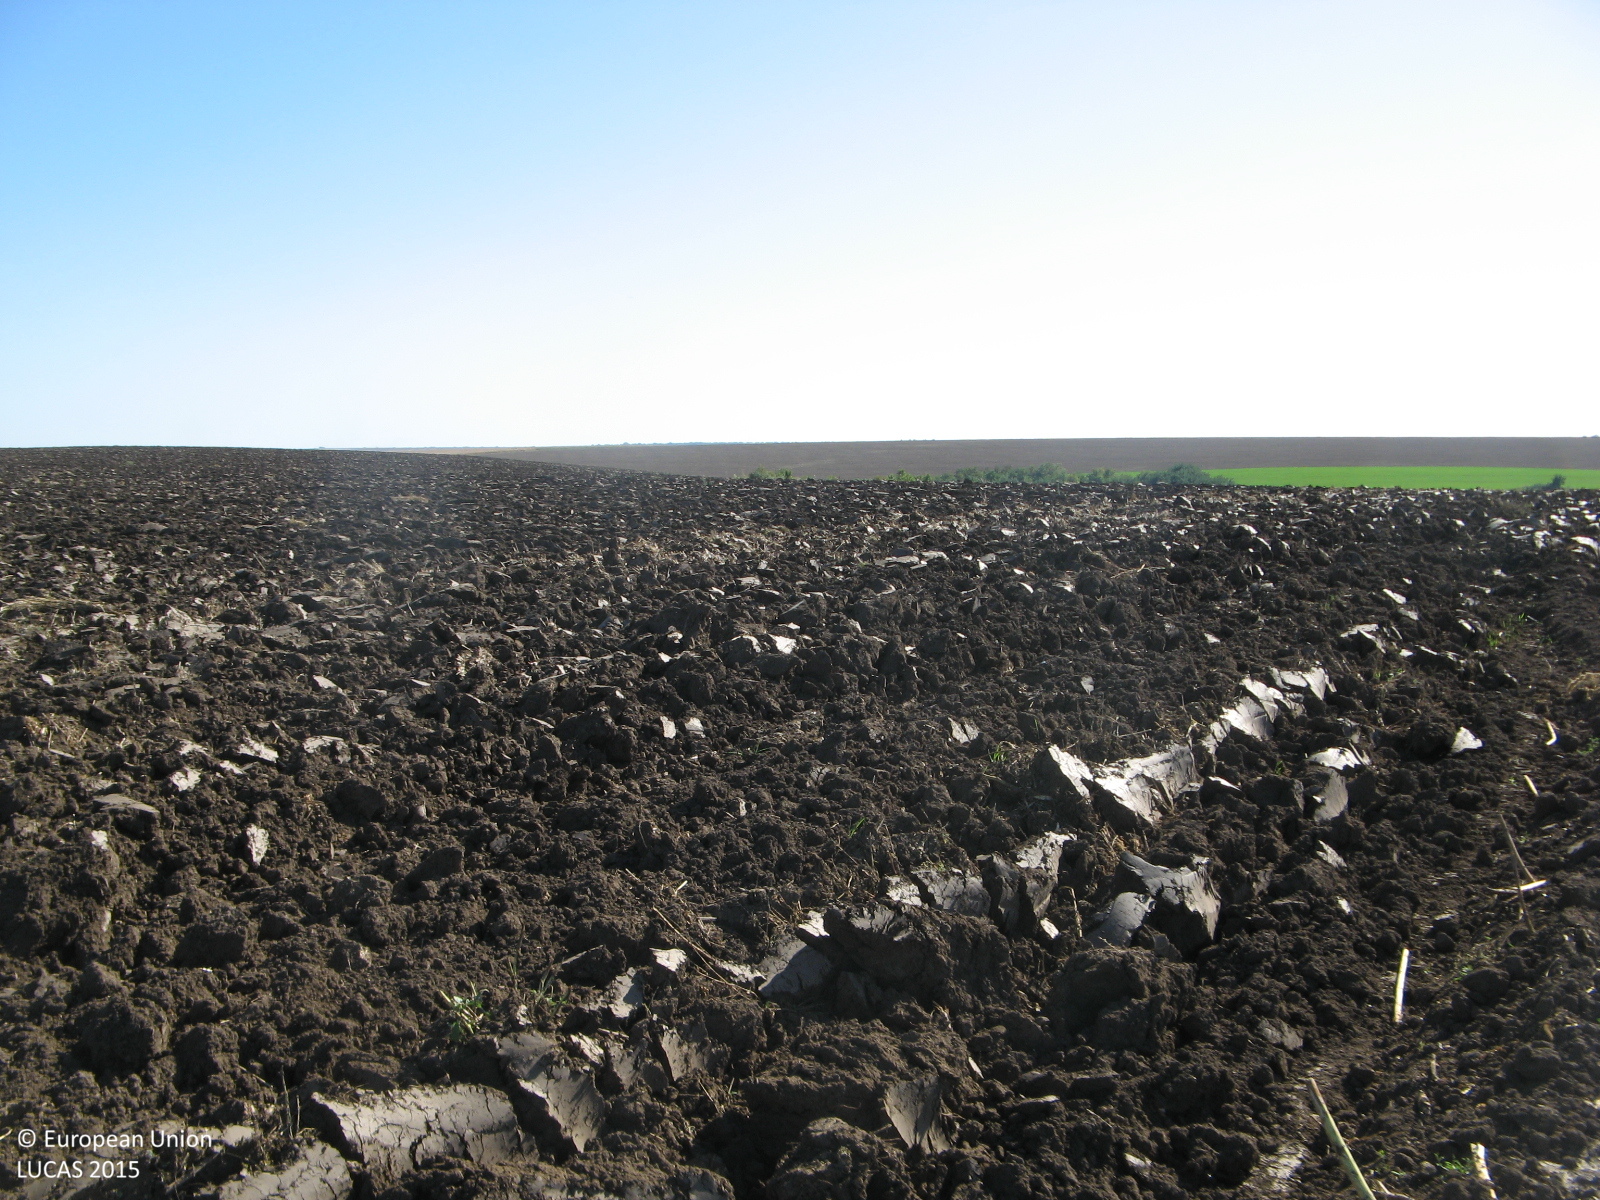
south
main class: Cropland
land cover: Sunflower
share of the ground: < 10 %
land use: Agriculture (excluding fallow land and kitchen gardens)
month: September
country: BG
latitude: 43.7263
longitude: 26.0991
